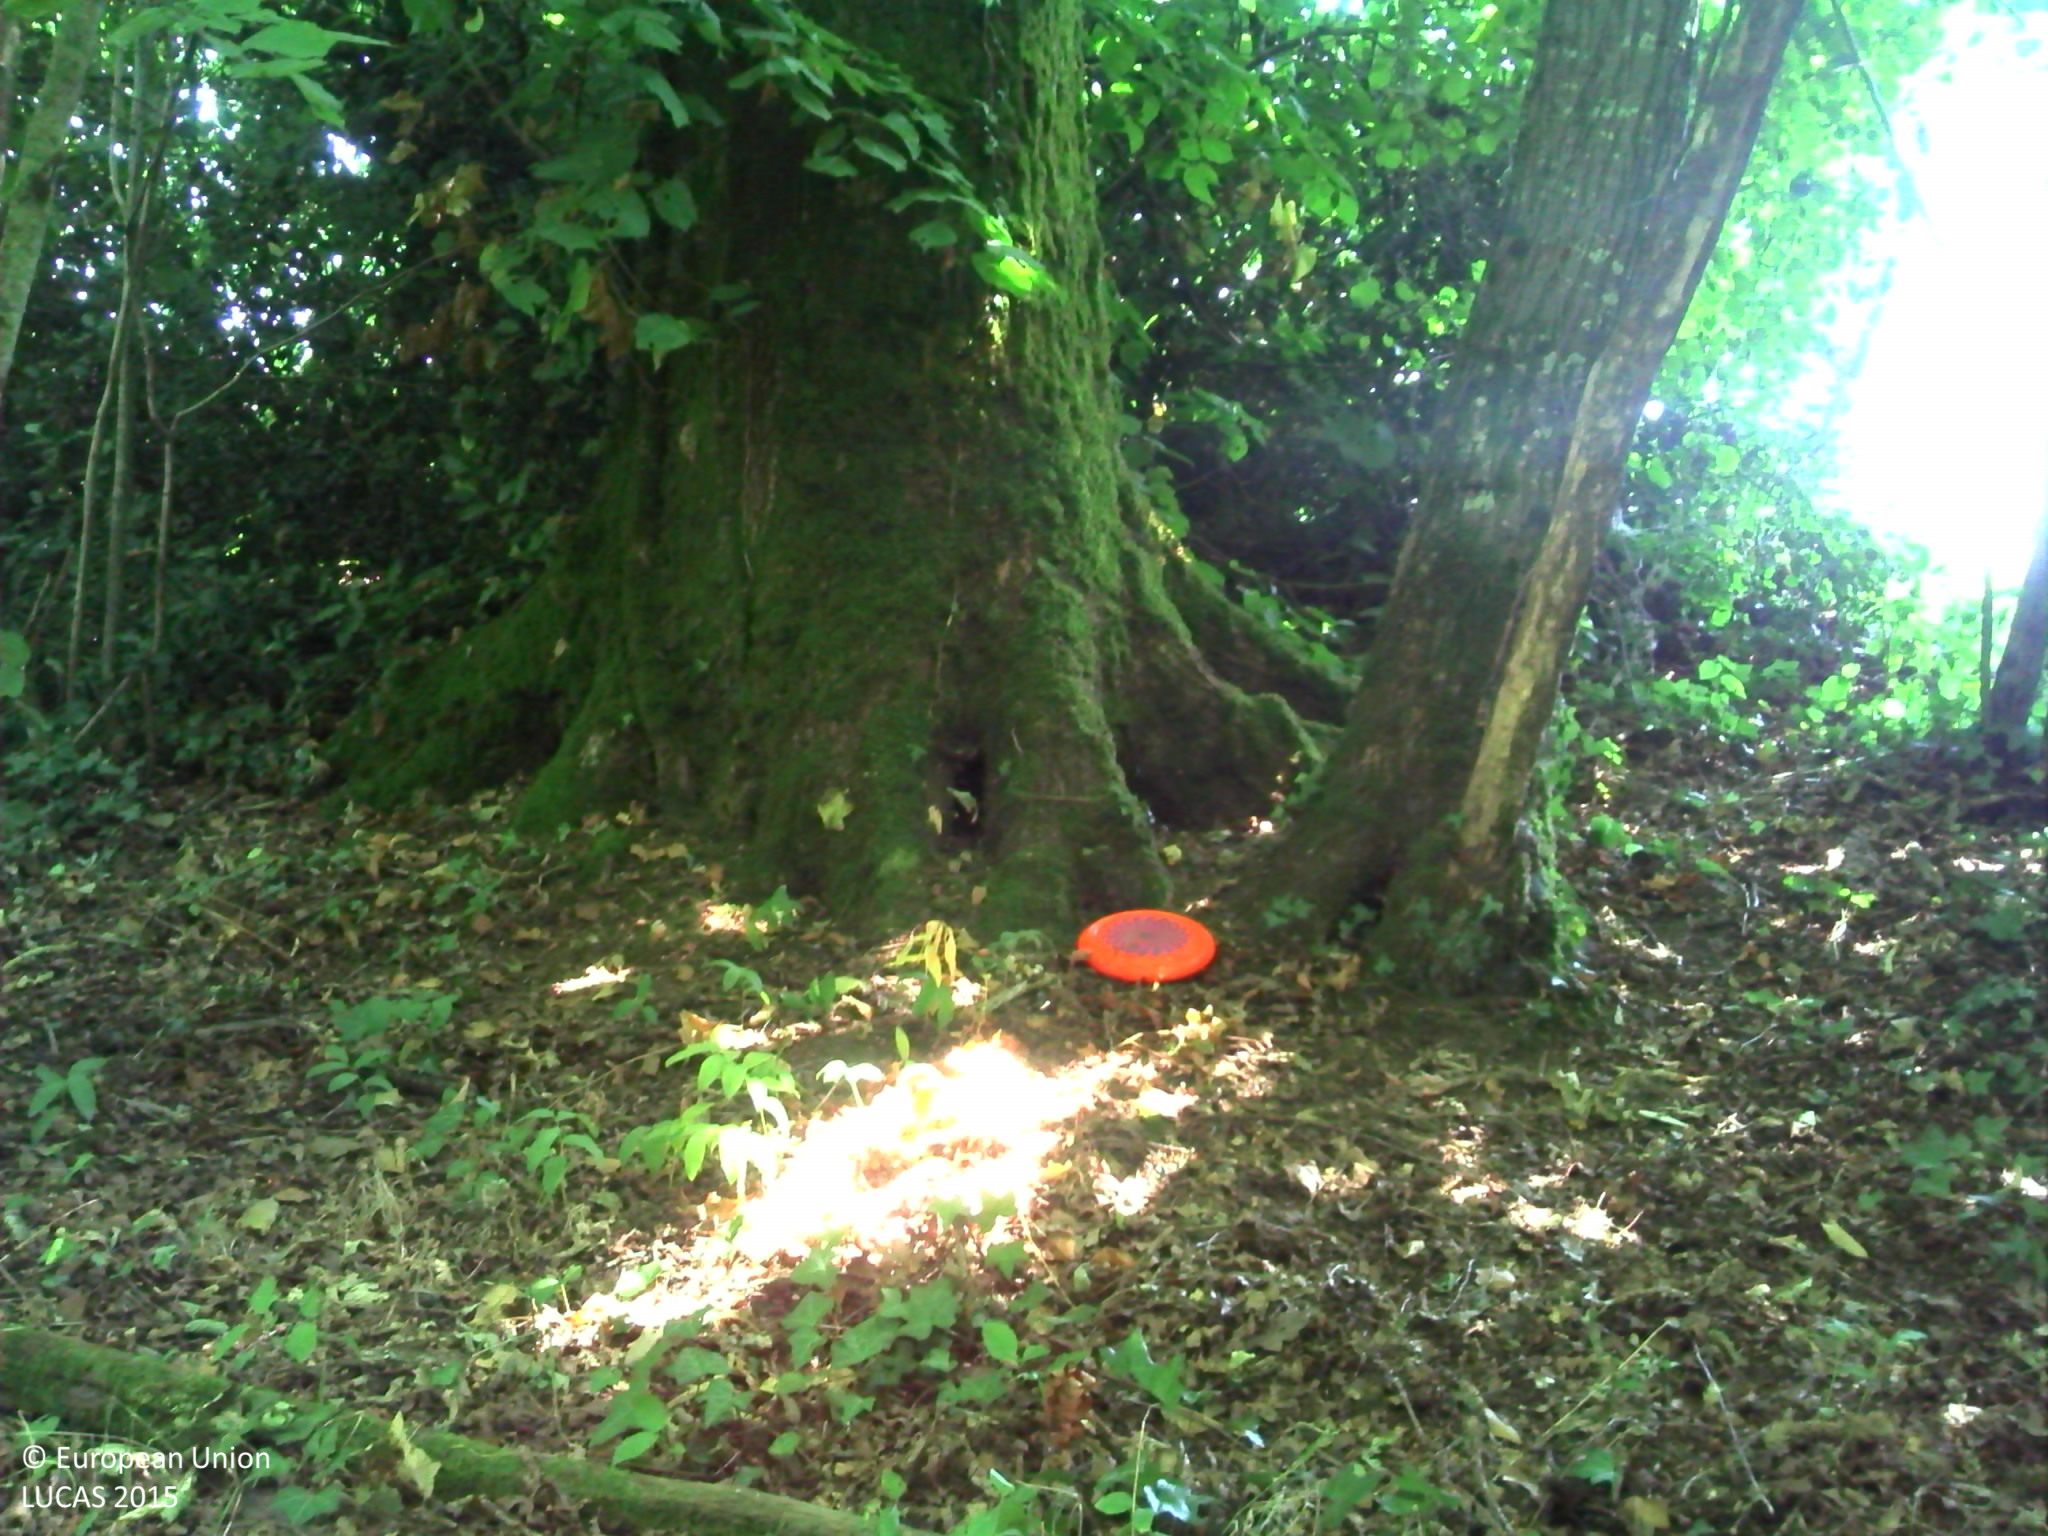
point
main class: Woodland
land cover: Broadleaved woodland
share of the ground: > 75 %
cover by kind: broadleaved forest trees 40 %, herbaceous plants 20 %, lichens and mosses 20 %, unconsolidated bare surface 20 %
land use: Forestry
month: July
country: FR
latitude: 45.6446
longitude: 0.9957
